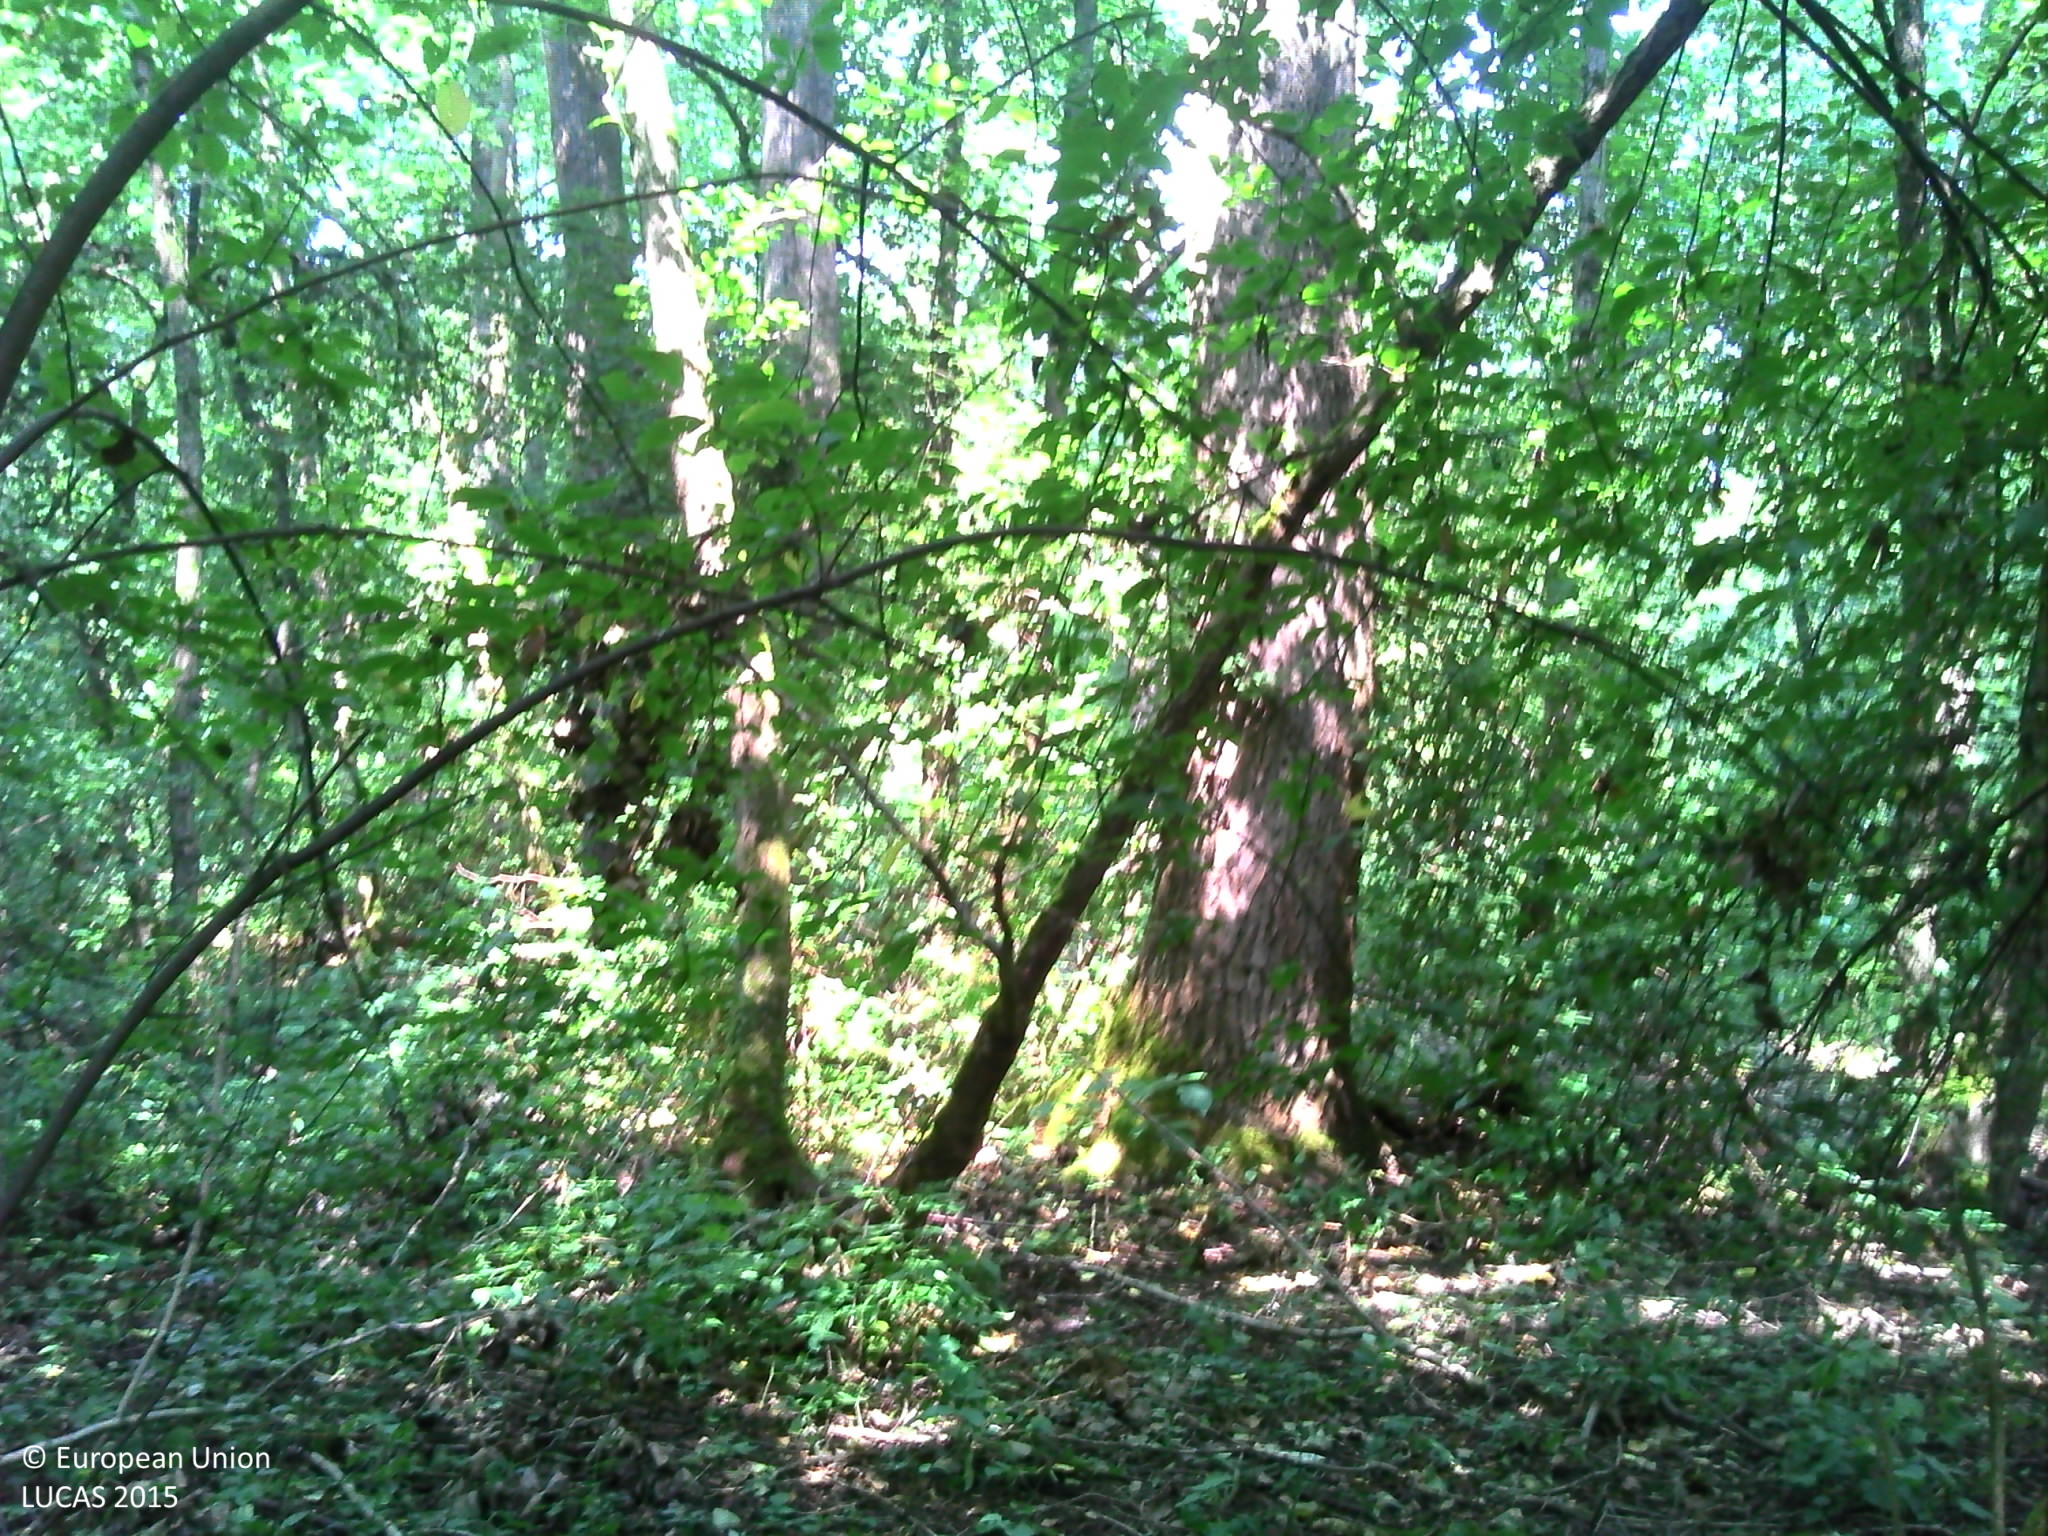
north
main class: Woodland
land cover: Broadleaved woodland
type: mesophytic deciduous forest
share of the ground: > 75 %
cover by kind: broadleaved forest trees 95 %, herbaceous plants 5 %
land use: Forestry
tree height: > 5 m
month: August
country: FR
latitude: 48.6514
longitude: 7.7882
